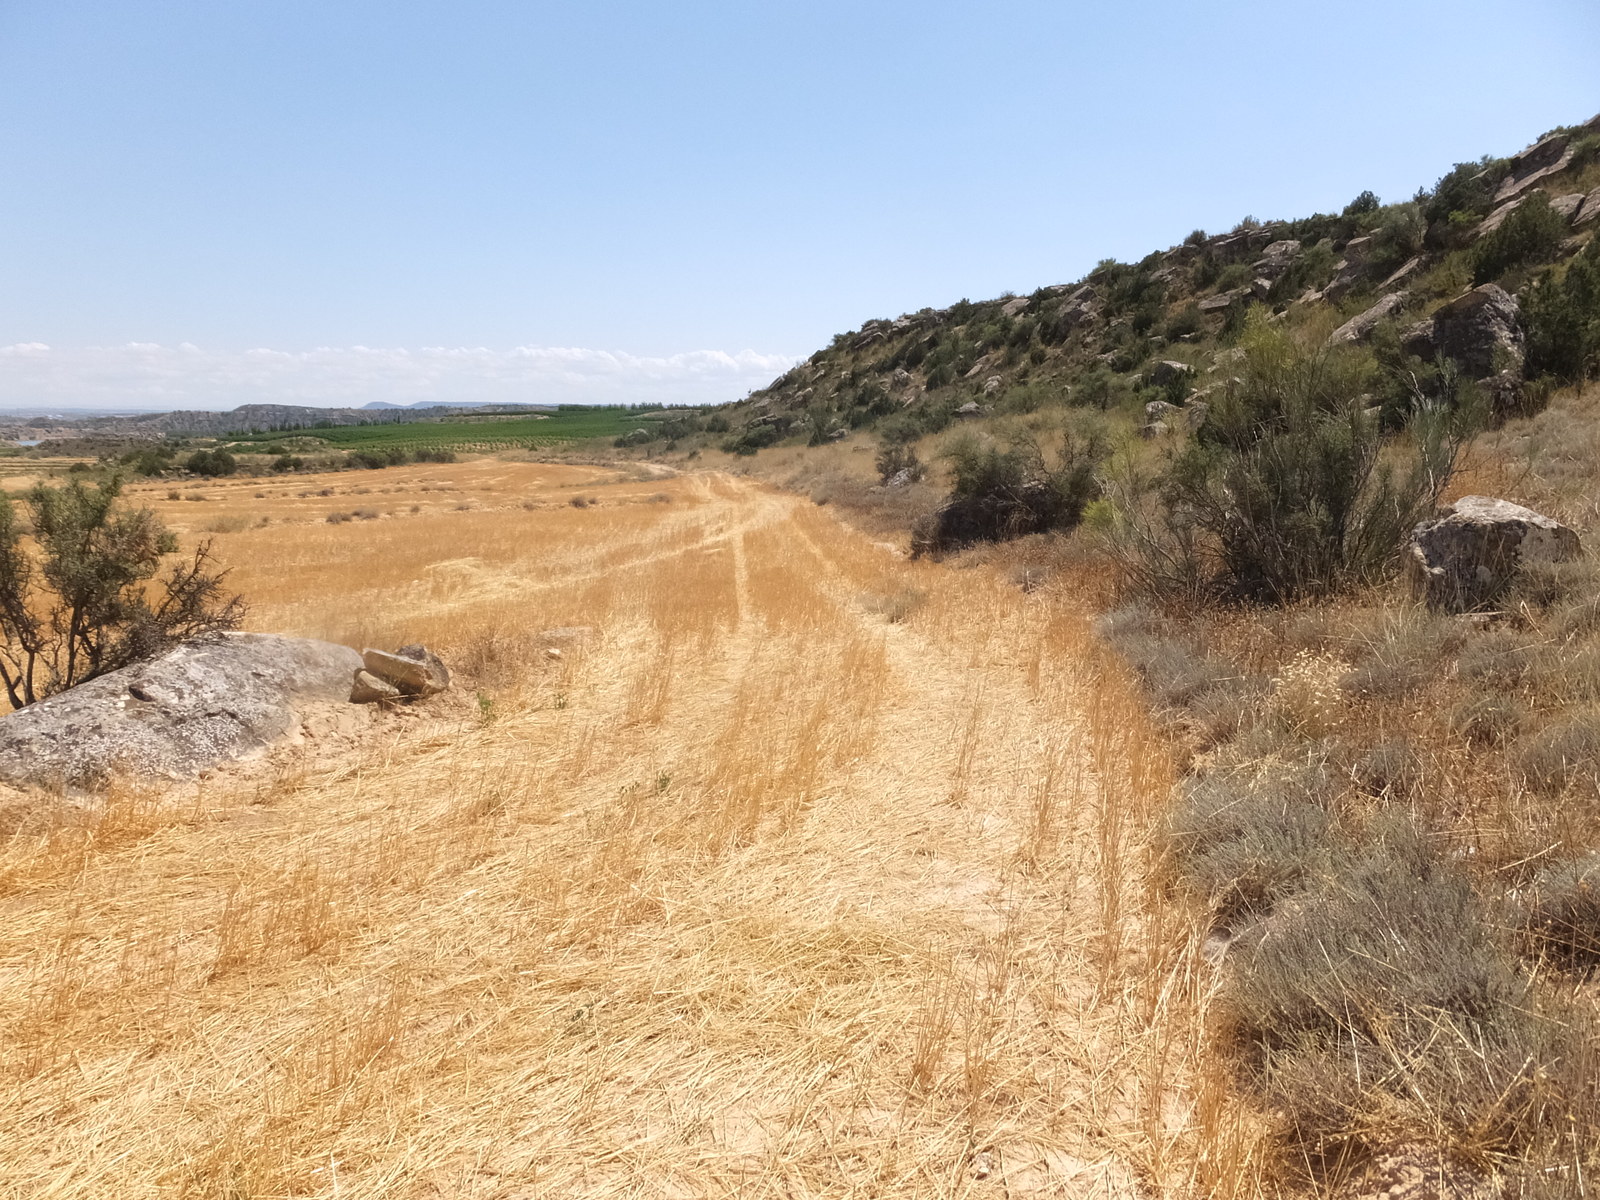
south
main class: Cropland
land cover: Barley
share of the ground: < 10 %
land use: Agriculture (excluding fallow land and kitchen gardens)
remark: Harvested field
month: June
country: ES
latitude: 41.2900
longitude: -0.1275
